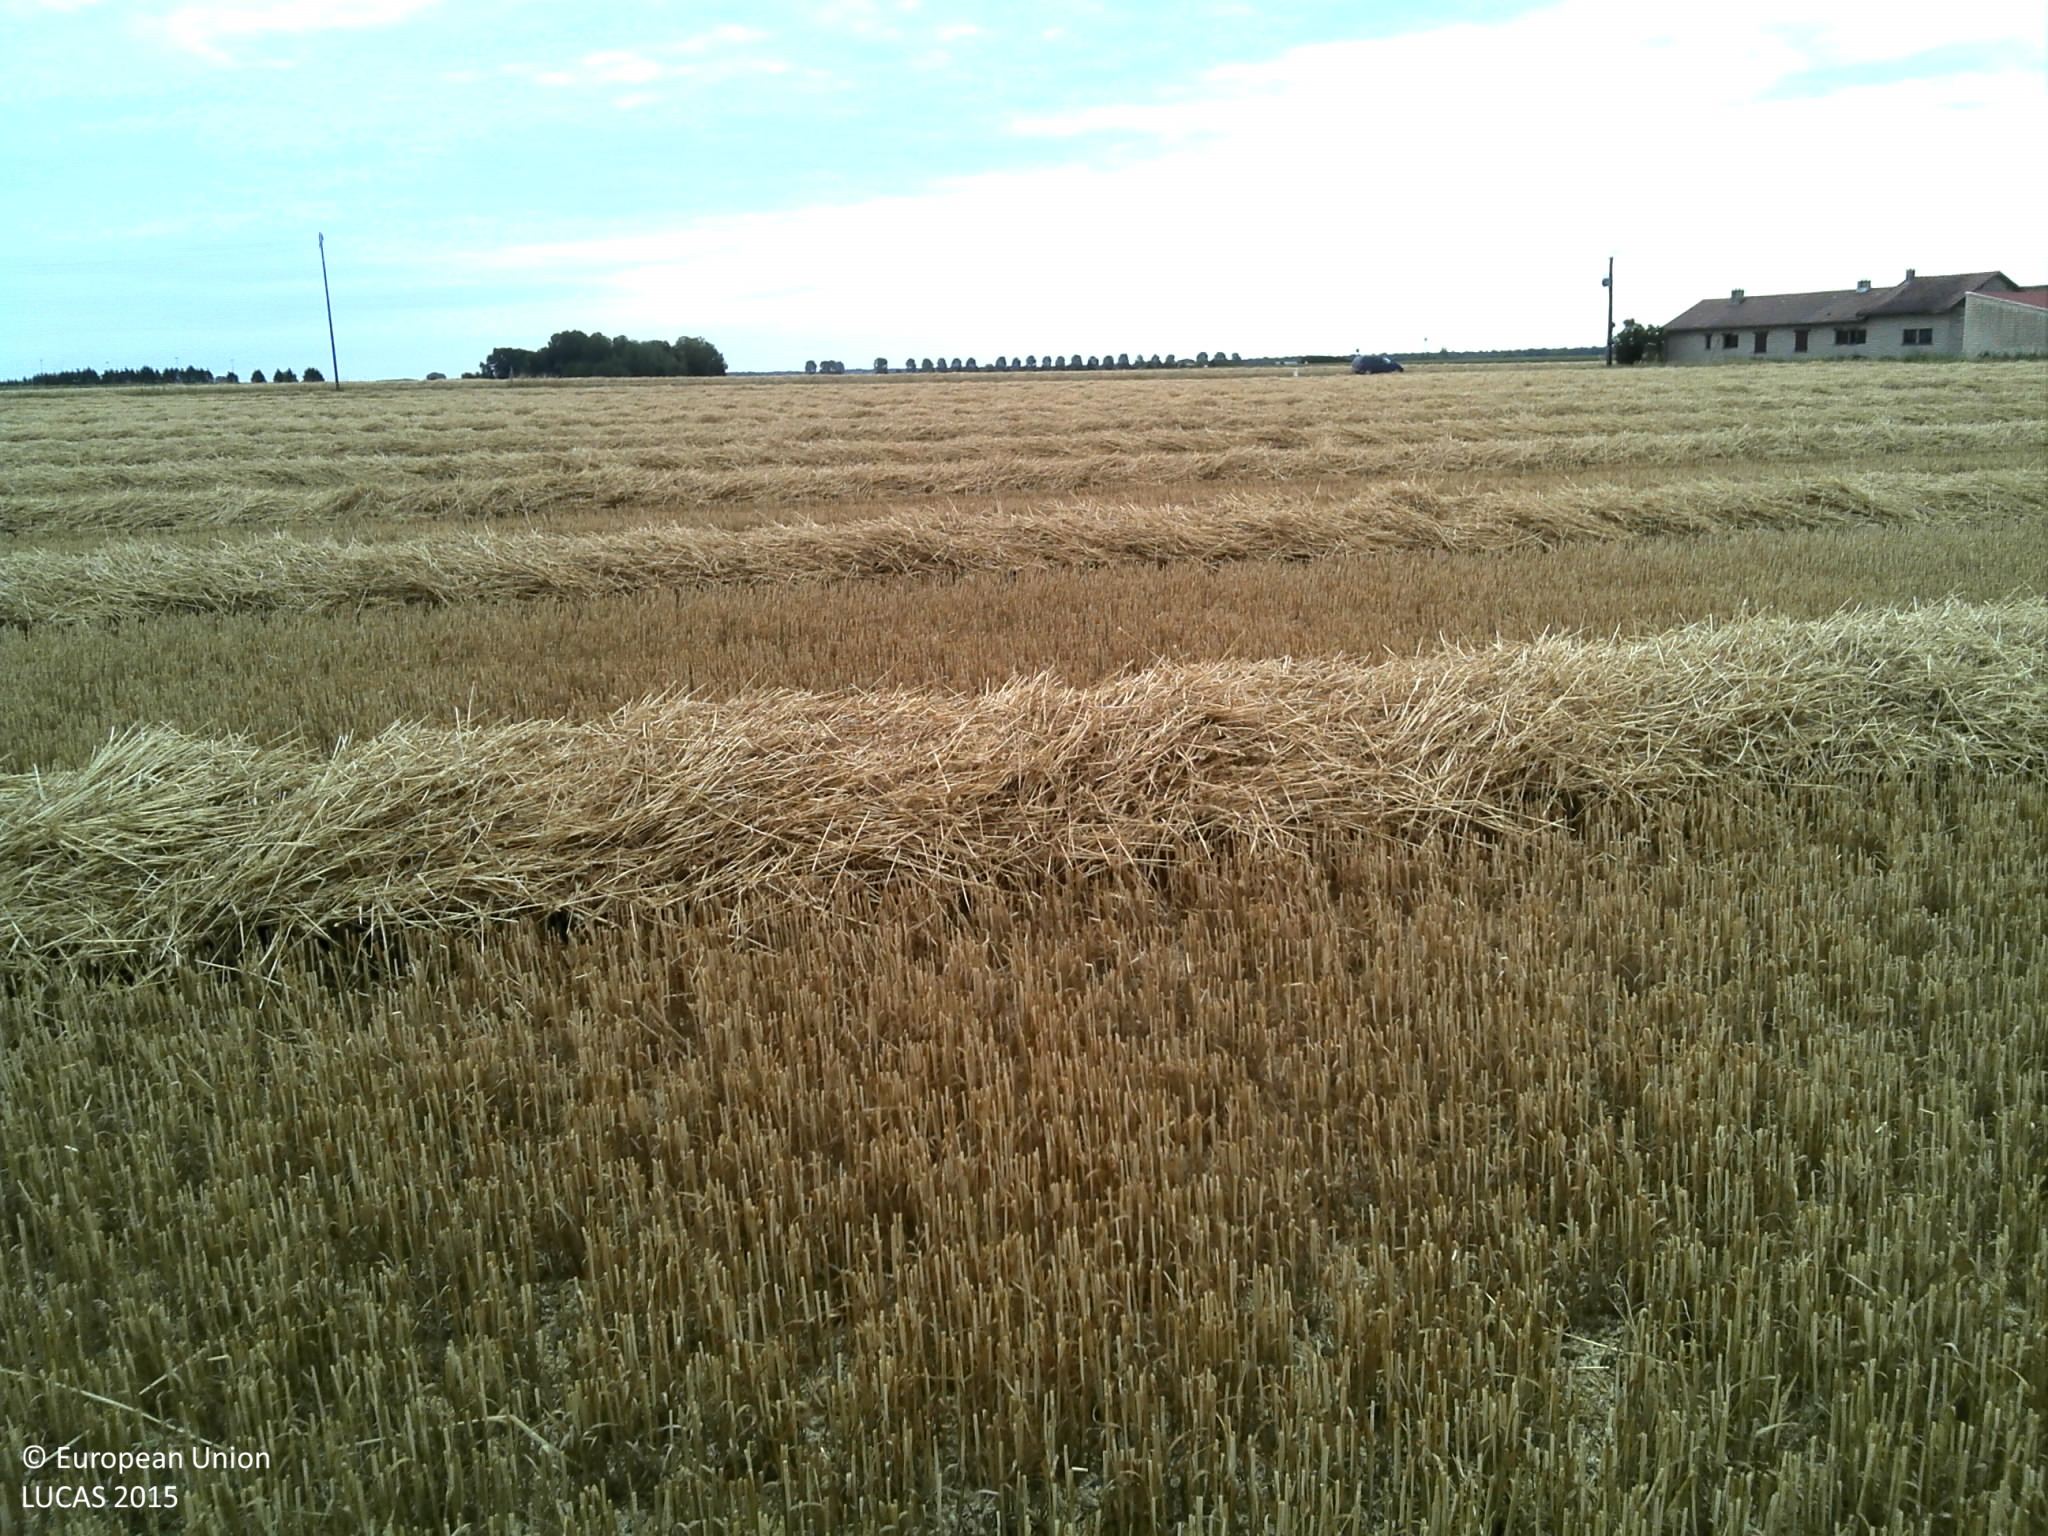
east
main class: Cropland
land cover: Common wheat
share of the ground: > 75 %
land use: Agriculture (excluding fallow land and kitchen gardens)
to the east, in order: Common wheat; Electric lines; Common wheat; Grass margins; Paved roads, cycling and walking lanes; Grass margins; Ditches and canals; Common wheat
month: July
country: FR
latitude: 48.7481
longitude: 4.7615
